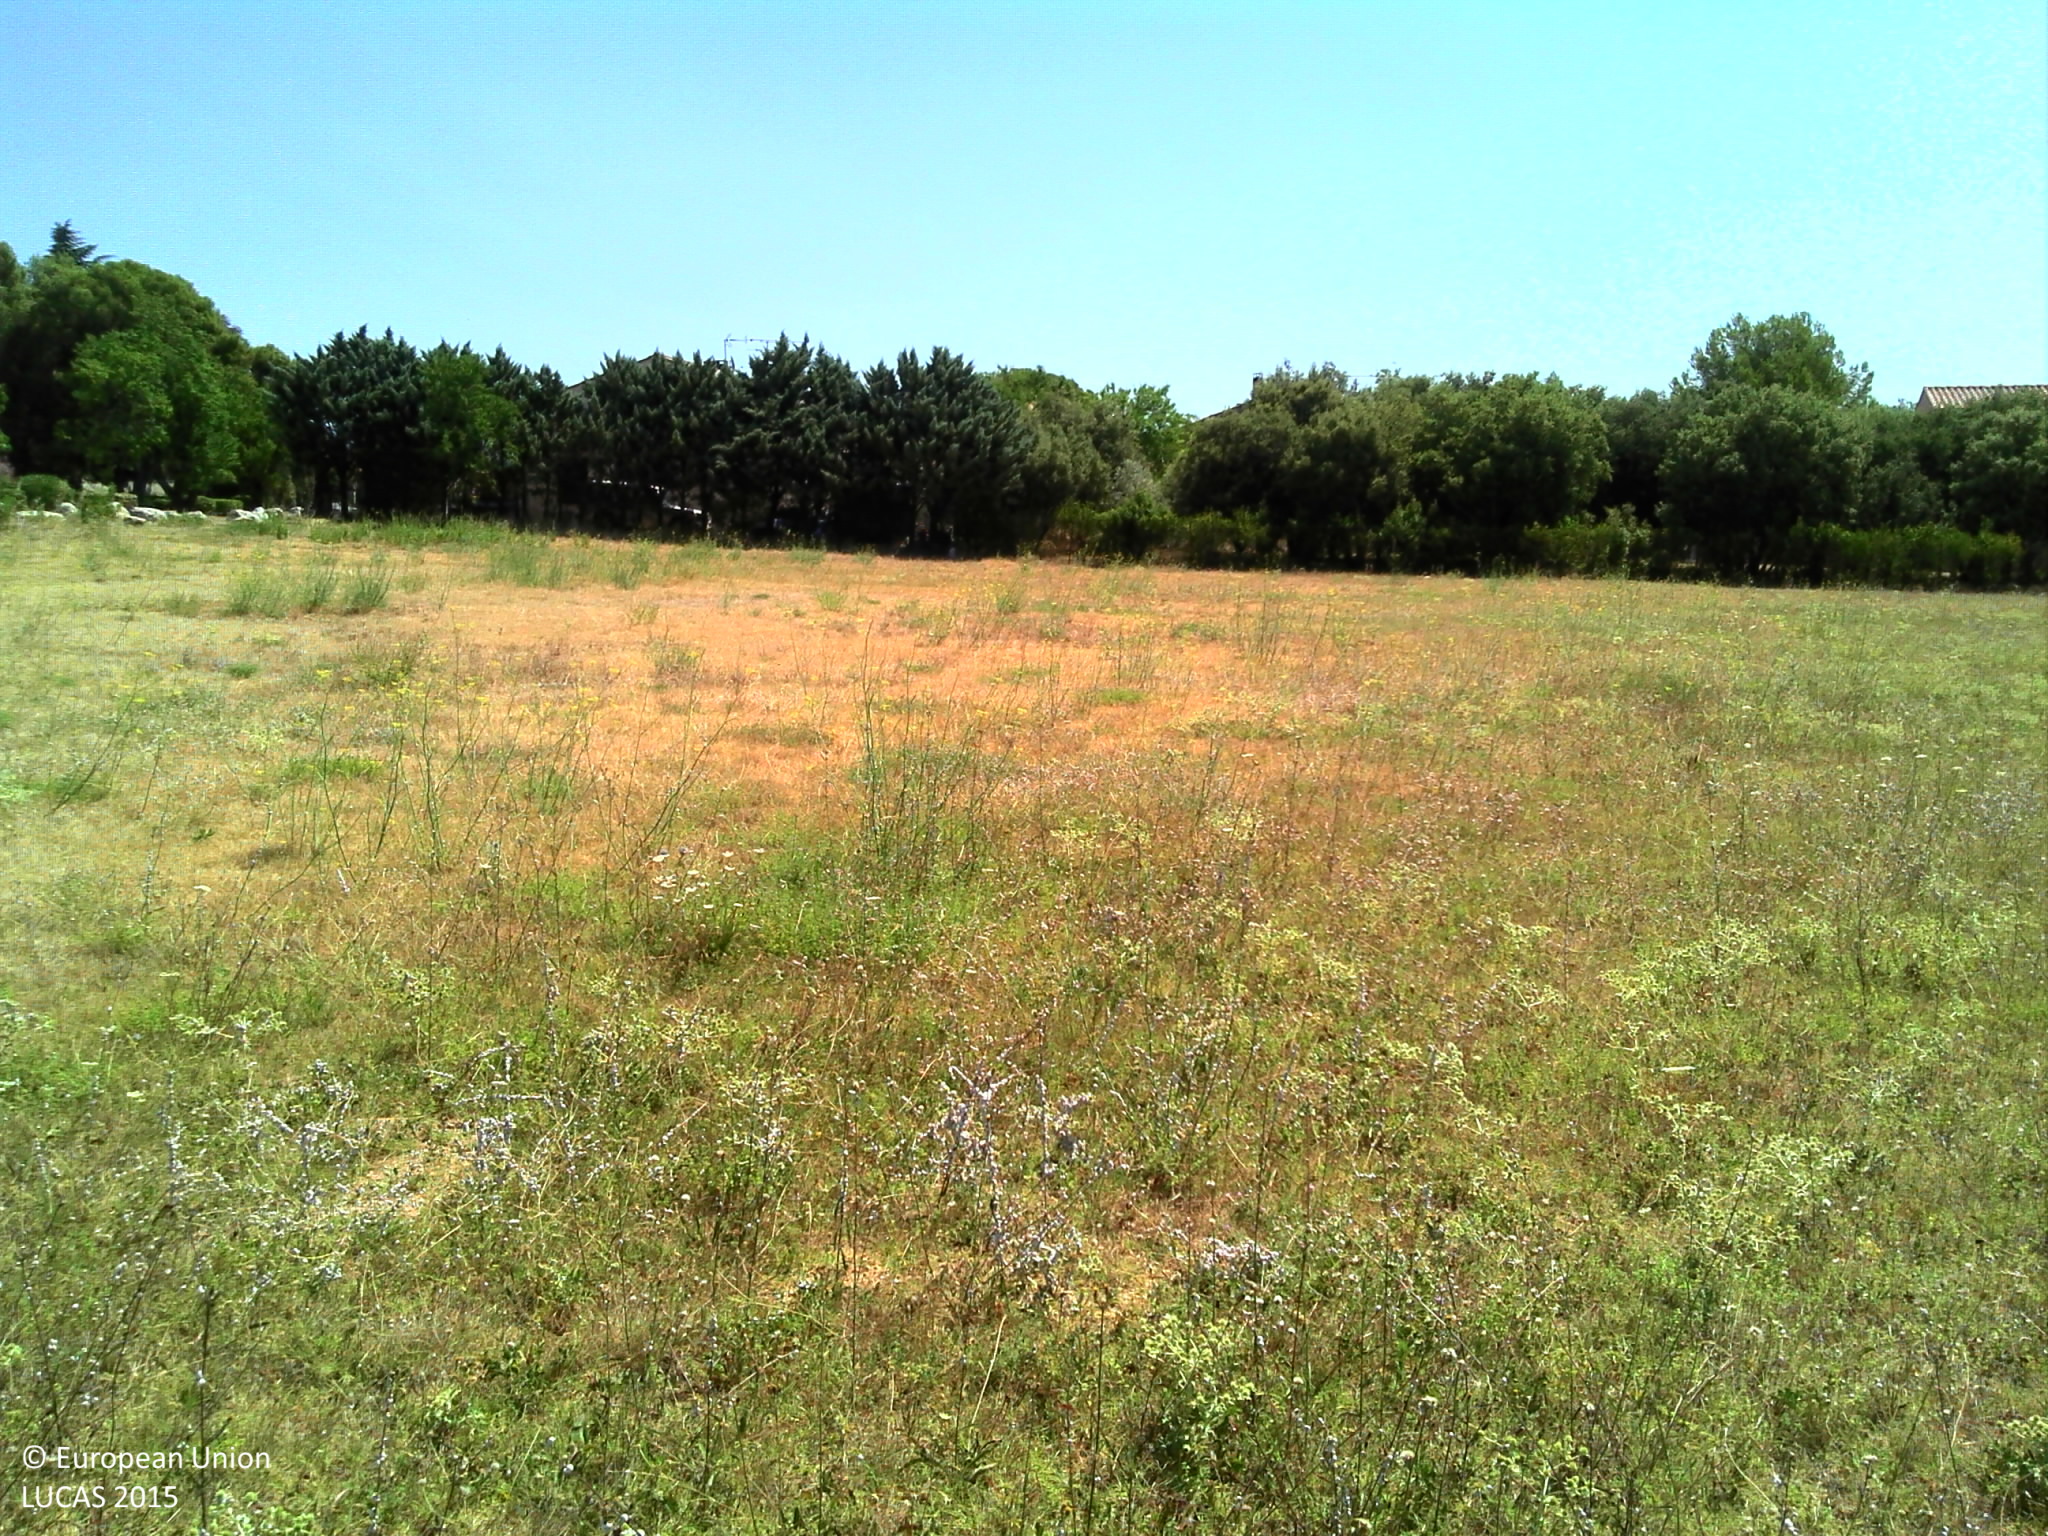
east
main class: Grassland
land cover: Grassland without tree/shrub cover
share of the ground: > 75 %
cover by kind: herbaceous plants 95 %, unconsolidated bare surface 5 %
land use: Agriculture (excluding fallow land and kitchen gardens)
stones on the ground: < 10 %
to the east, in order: Grassland without tree/shrub cover; Artificial constructions in urban areas
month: July
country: FR
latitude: 43.7518
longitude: 5.2029
